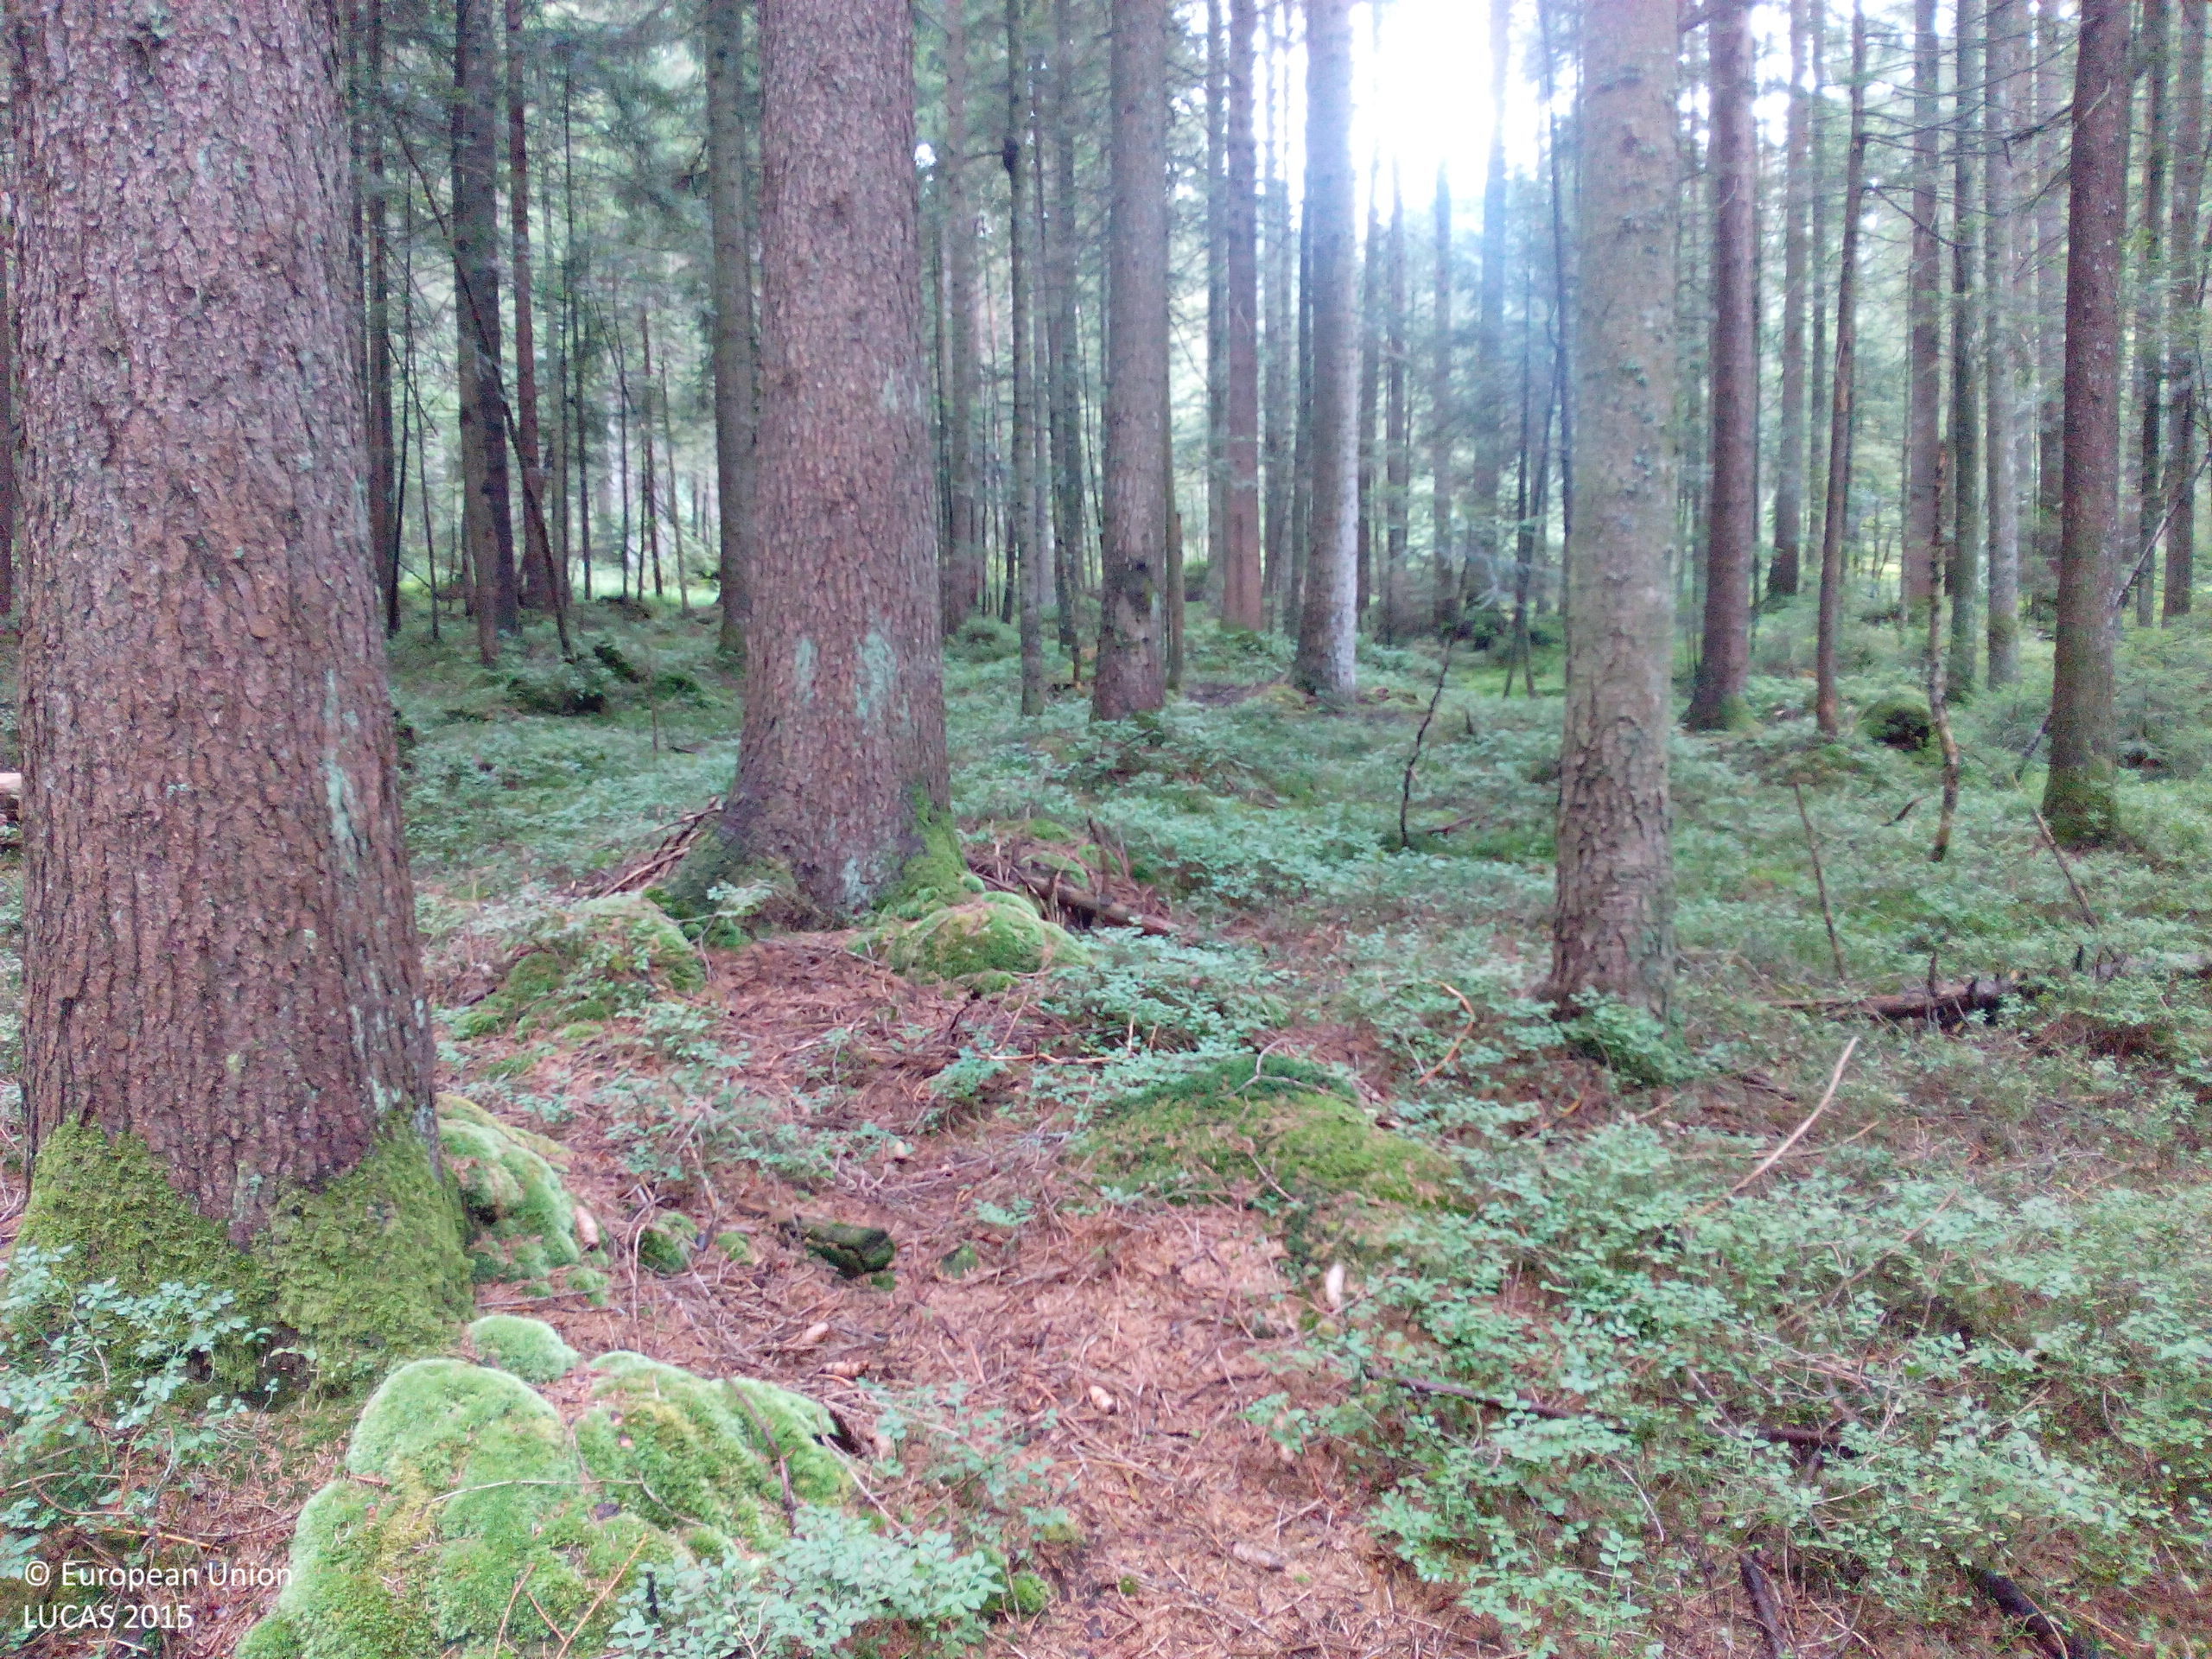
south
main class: Woodland
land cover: Spruce dominated coniferous woodland
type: hemiboreal forest and nemoral coniferous forest and mixed broadleaved-coniferous forest
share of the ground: > 75 %
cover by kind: coniferous forest trees 75 %, shrubs 15 %, unconsolidated bare surface 10 %
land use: Forestry
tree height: > 5 m
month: September
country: DE
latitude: 48.9586
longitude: 12.9359
